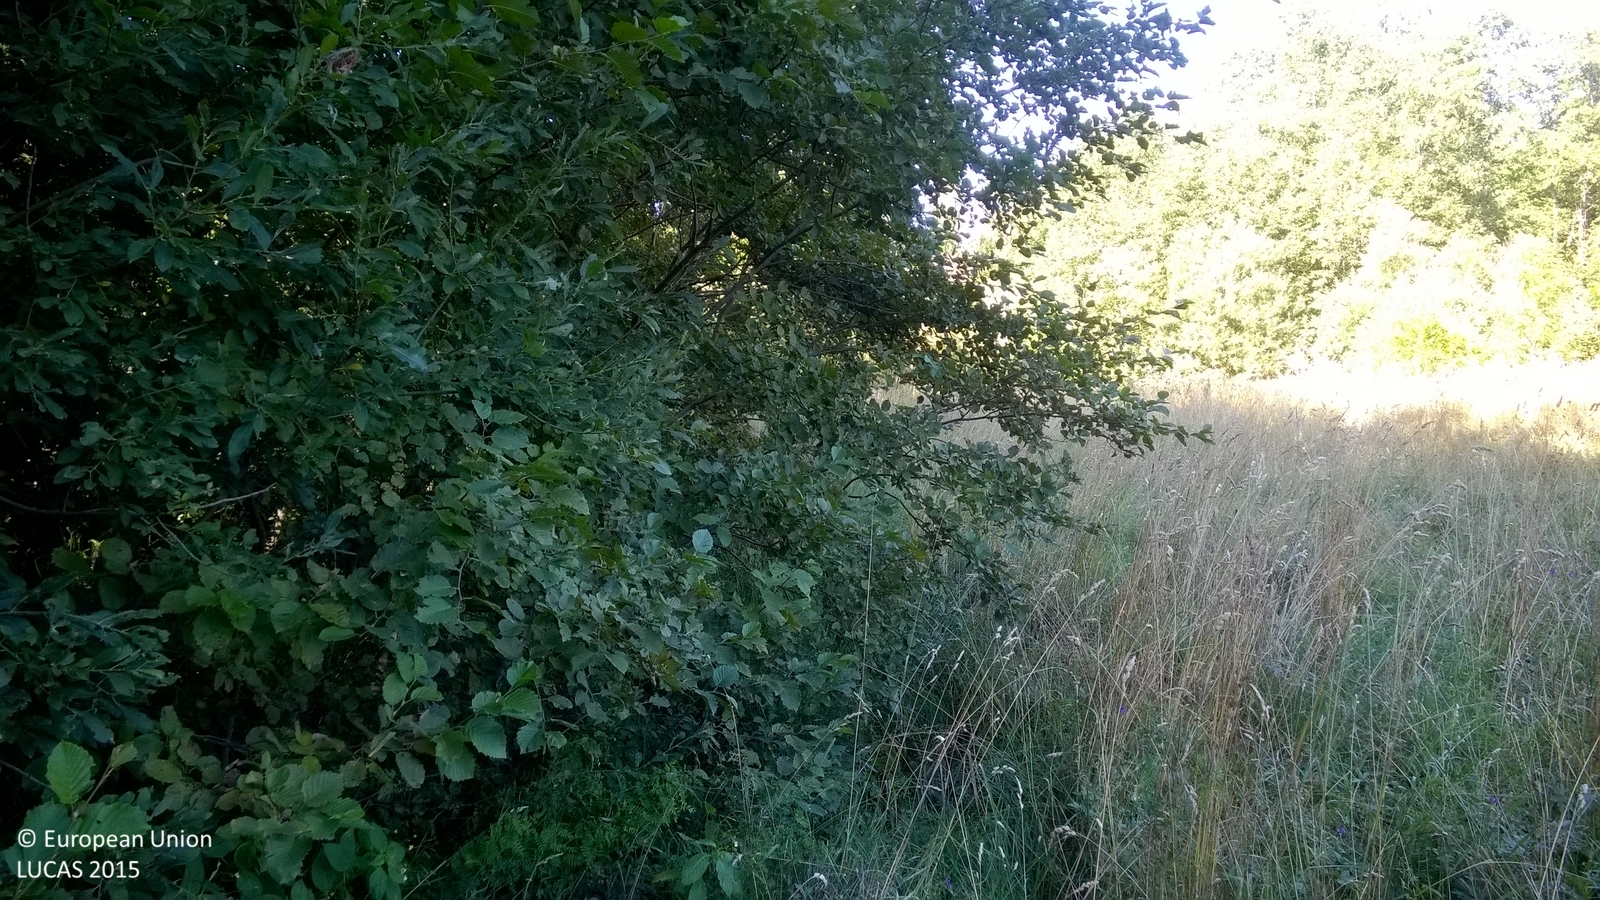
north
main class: Woodland
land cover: Broadleaved woodland
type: non-riverine alder, birch or aspen forest
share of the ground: > 75 %
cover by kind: broadleaved forest trees 90 %, shrubs 5 %, herbaceous plants 5 %
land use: Forestry
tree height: > 5 m
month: August
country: LV
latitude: 57.2899
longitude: 25.5309
